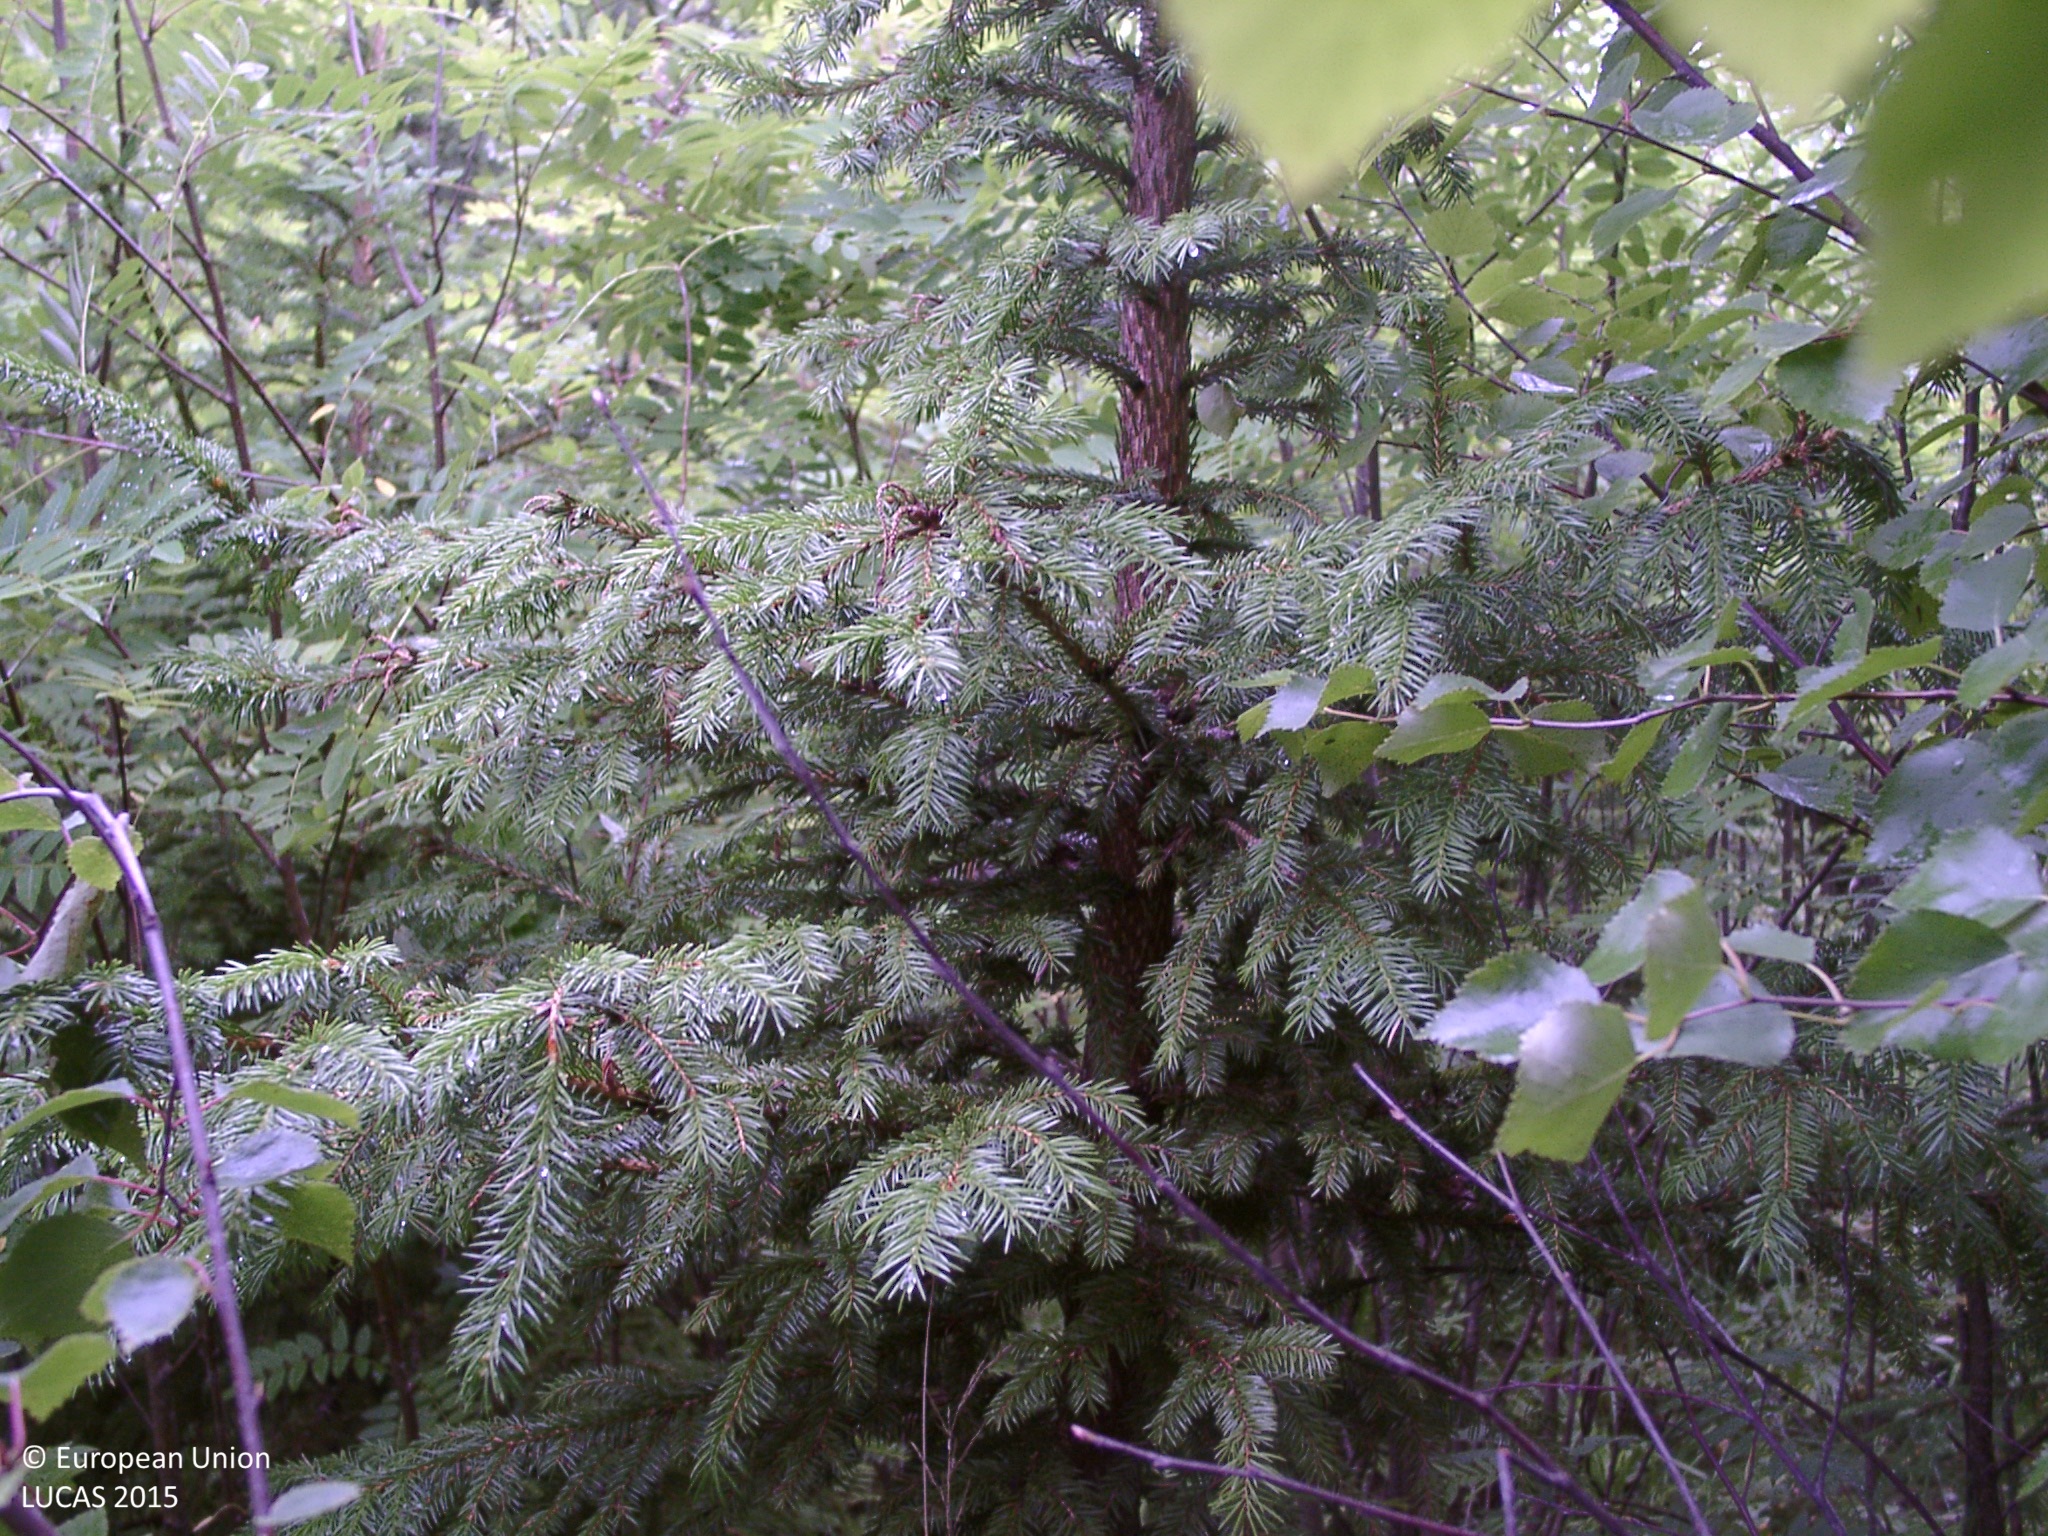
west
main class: Woodland
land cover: Spruce dominated mixed woodland
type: boreal forest
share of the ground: > 75 %
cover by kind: broadleaved forest trees 60 %, coniferous forest trees 20 %, herbaceous plants 20 %
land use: Forestry
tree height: < 5 m
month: July
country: FI
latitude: 62.2360
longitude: 25.4102
